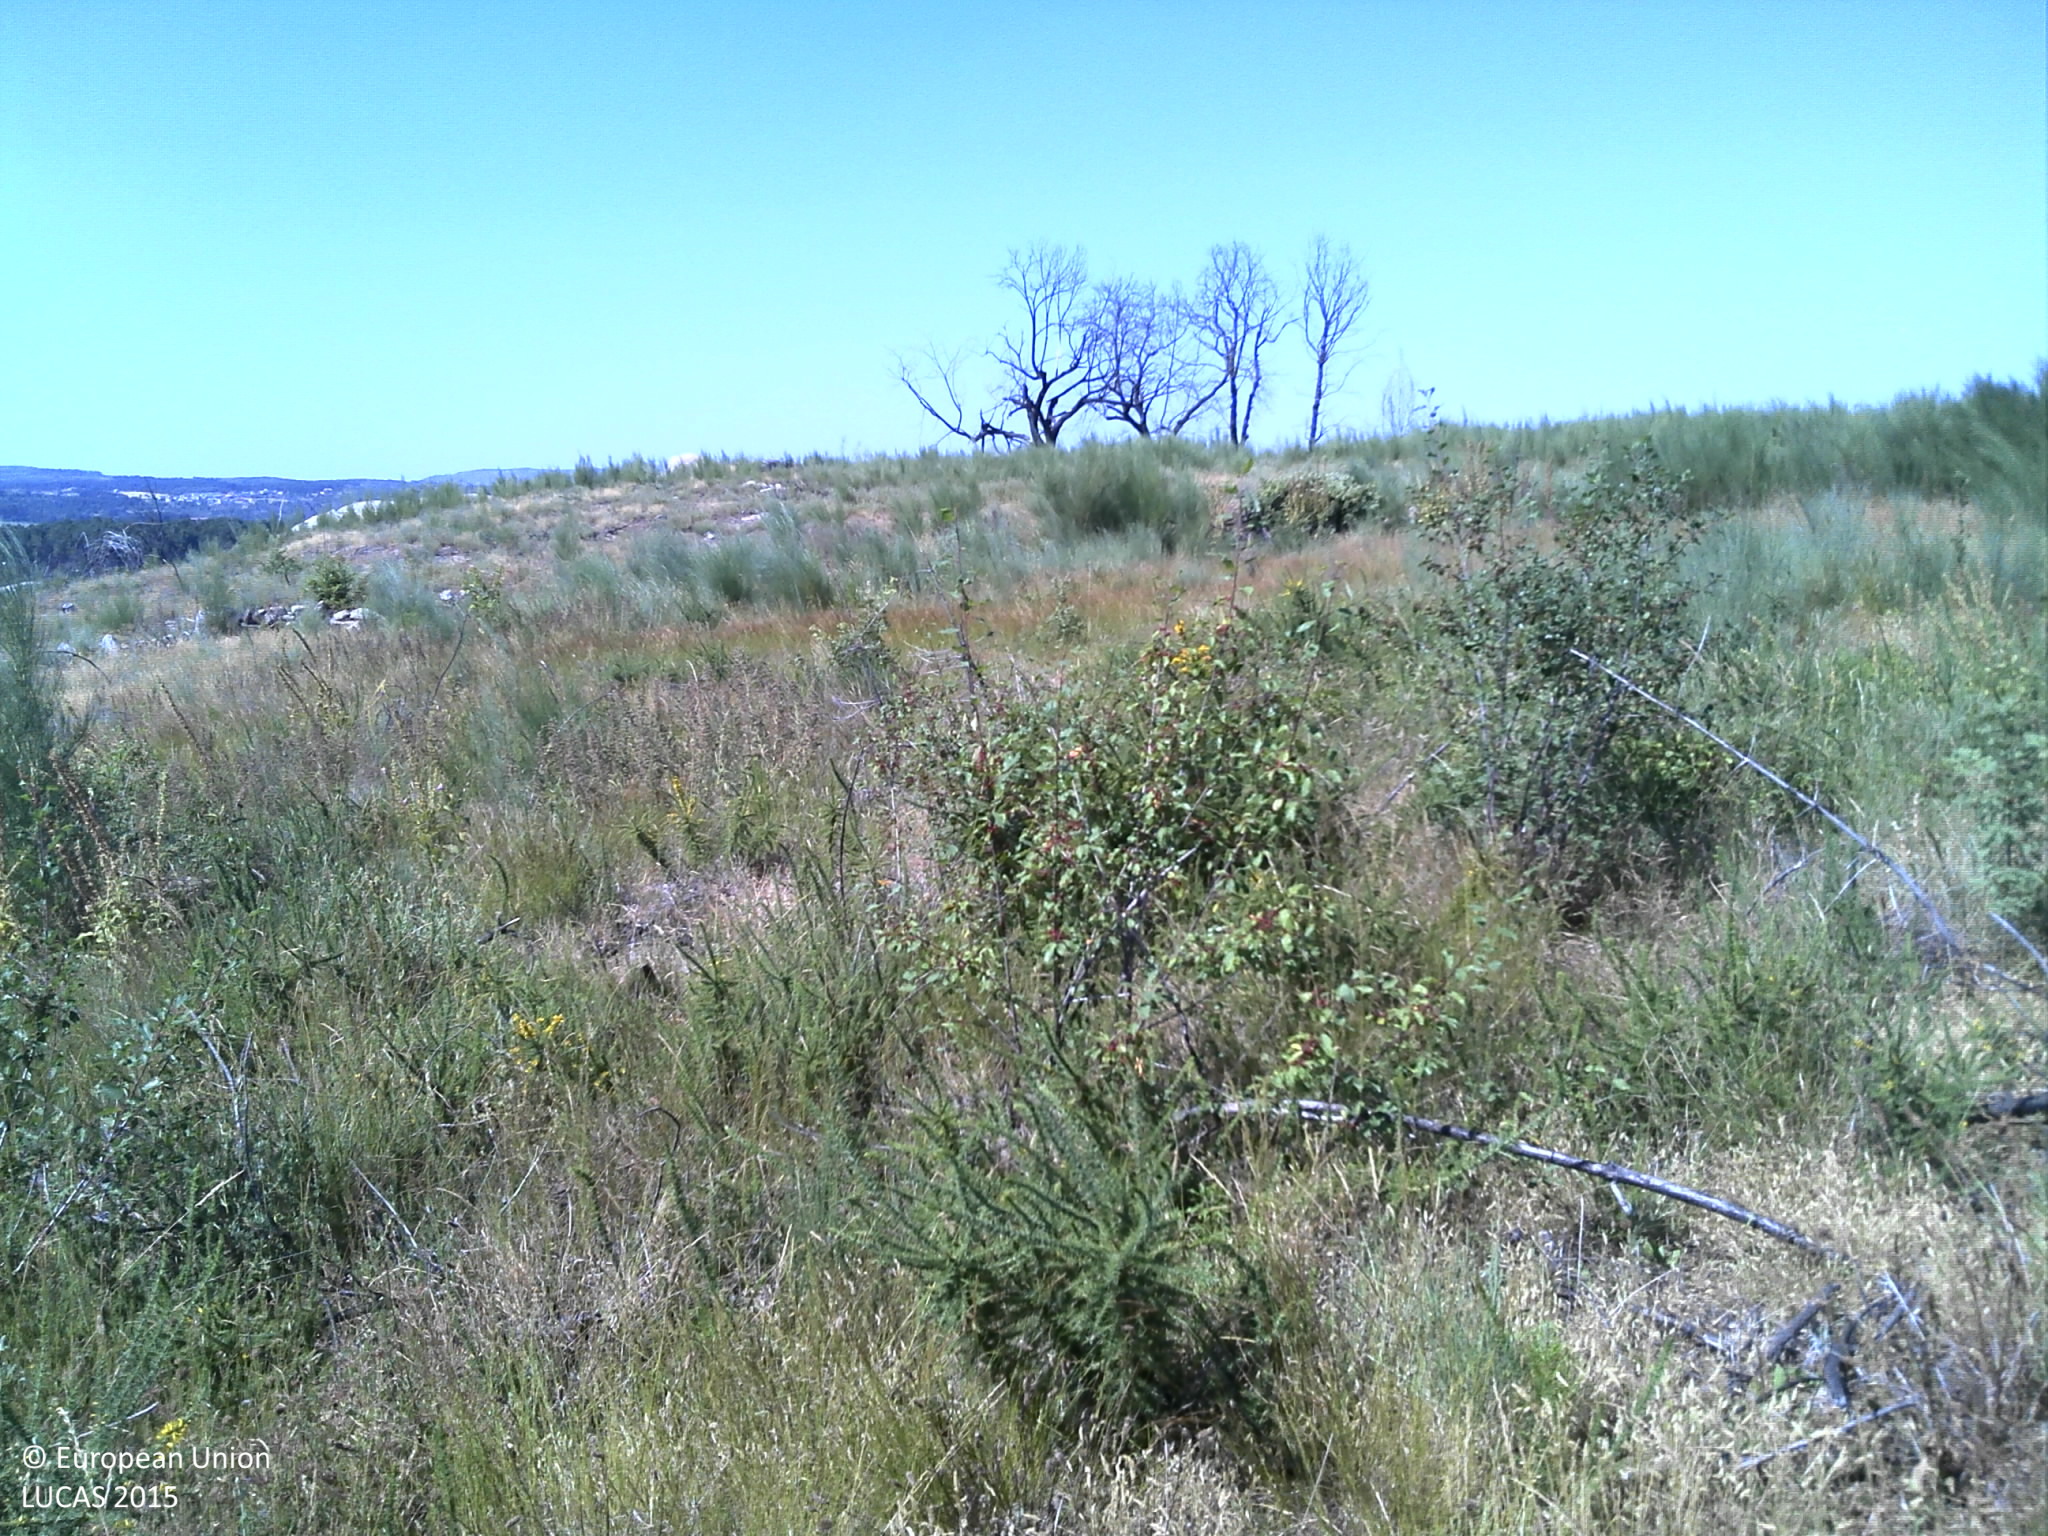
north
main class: Shrubland
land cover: Shrubland without tree cover
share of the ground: > 75 %
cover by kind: shrubs 90 %, herbaceous plants 10 %
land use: Abandoned areas
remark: Burnt area
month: July
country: PT
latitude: 40.7670
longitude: -7.4947
